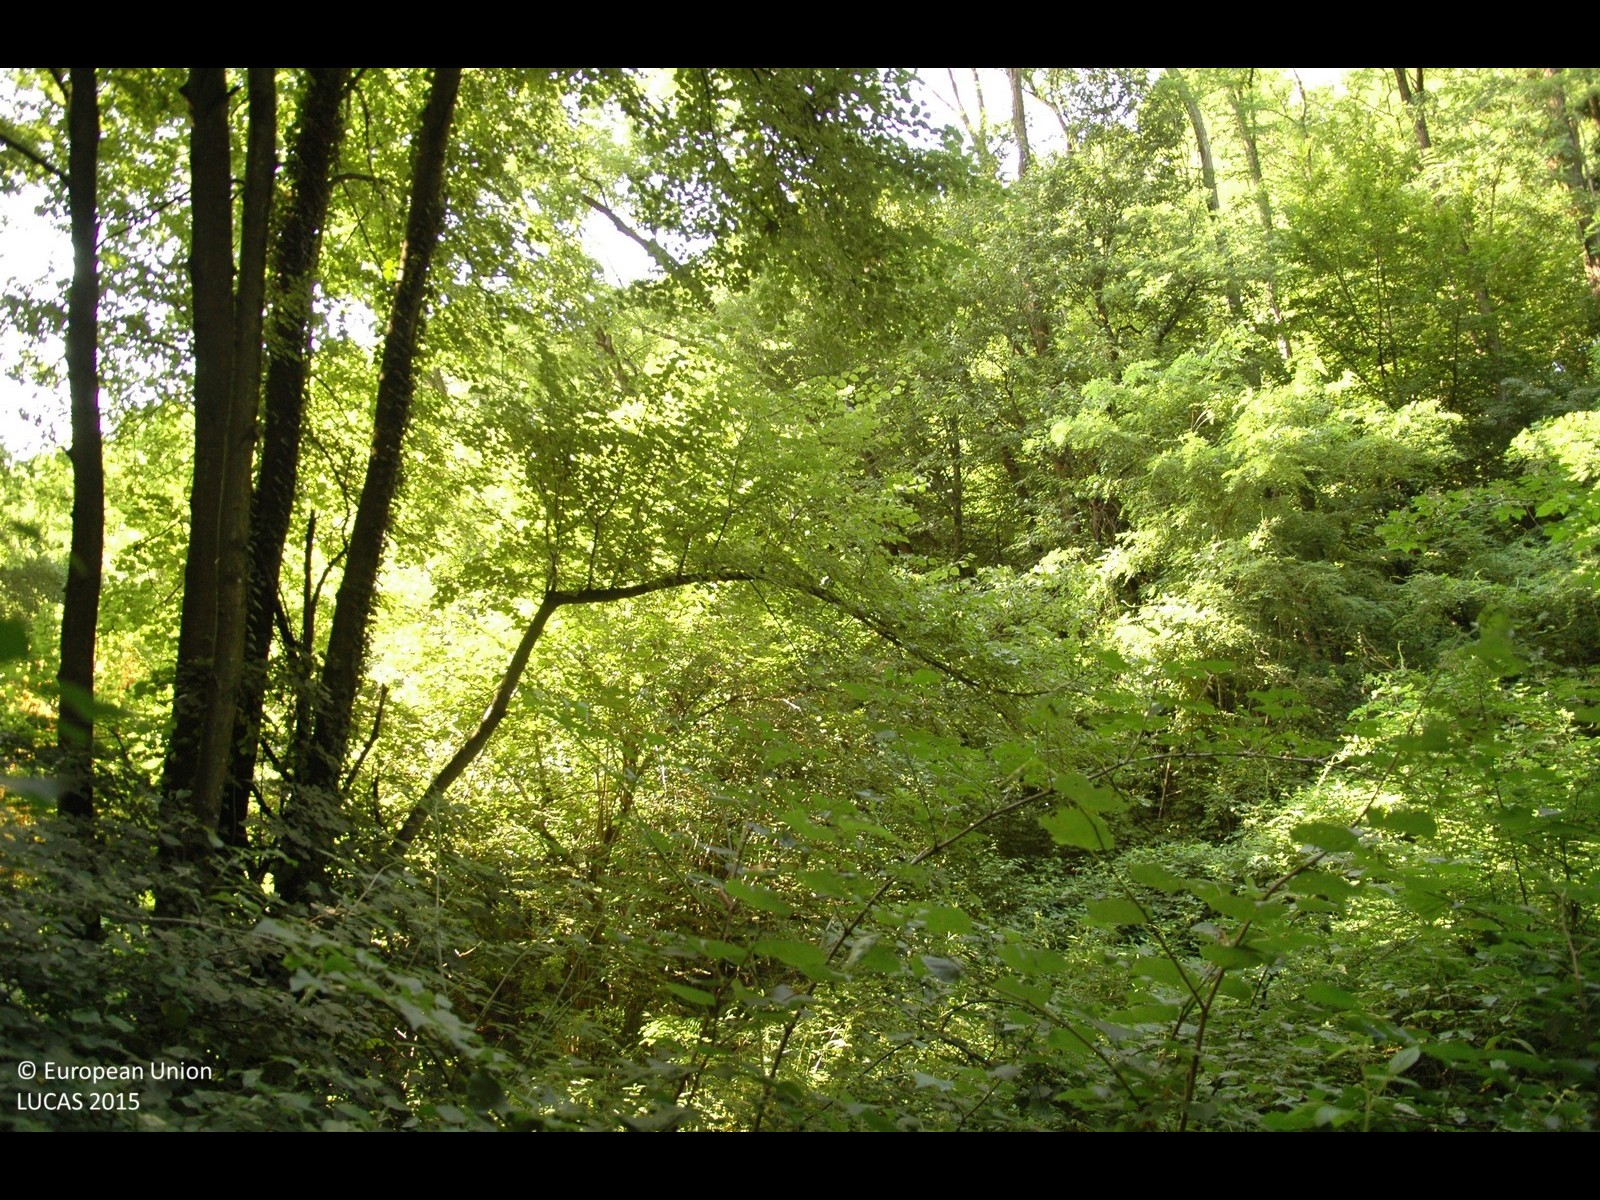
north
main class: Woodland
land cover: Broadleaved woodland
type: mesophytic deciduous forest
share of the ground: > 75 %
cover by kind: broadleaved forest trees 100 %
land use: Forestry
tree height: > 5 m
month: July
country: HR
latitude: 46.0305
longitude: 16.1356
